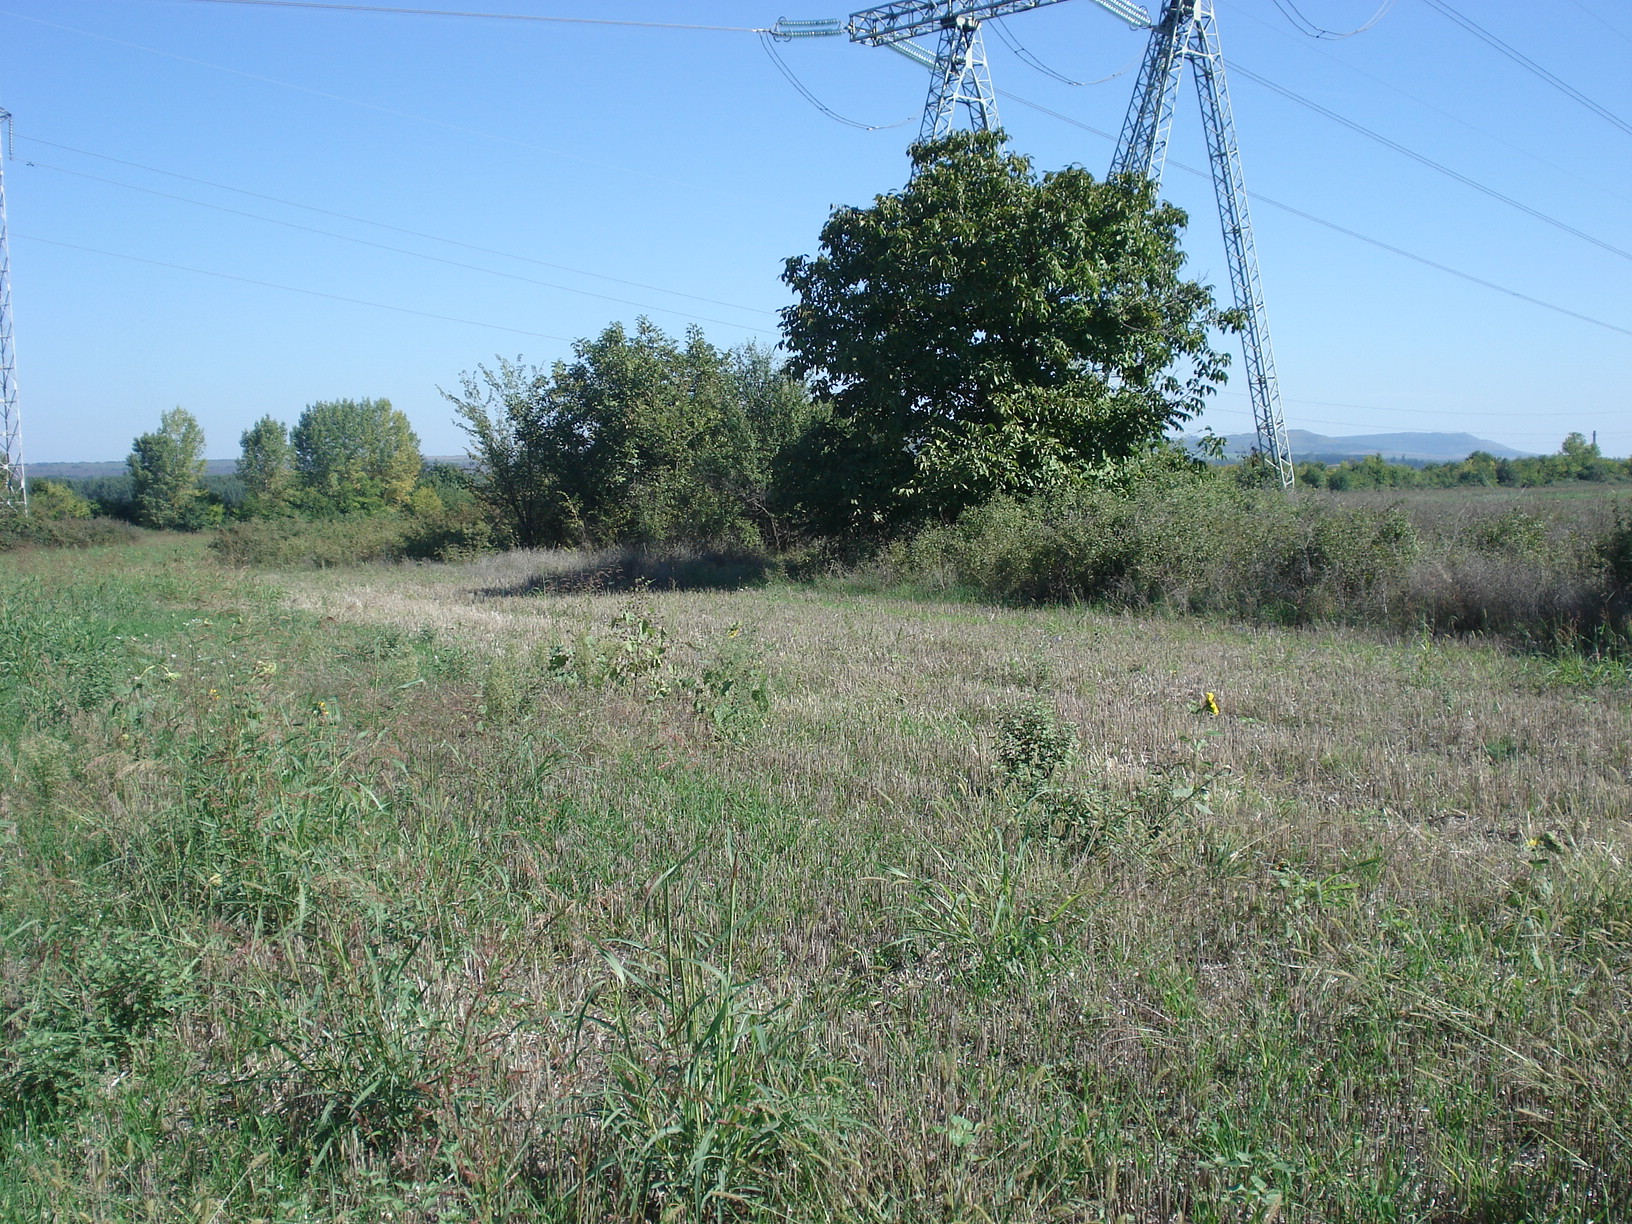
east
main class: Cropland
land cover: Common wheat
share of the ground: < 10 %
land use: Agriculture (excluding fallow land and kitchen gardens)
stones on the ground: < 10 %
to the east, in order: Common wheat; Shrubland with sparse tree cover; Common wheat; Electric lines; Common wheat; Sunflower
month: October
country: BG
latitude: 43.2293
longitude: 25.2800
